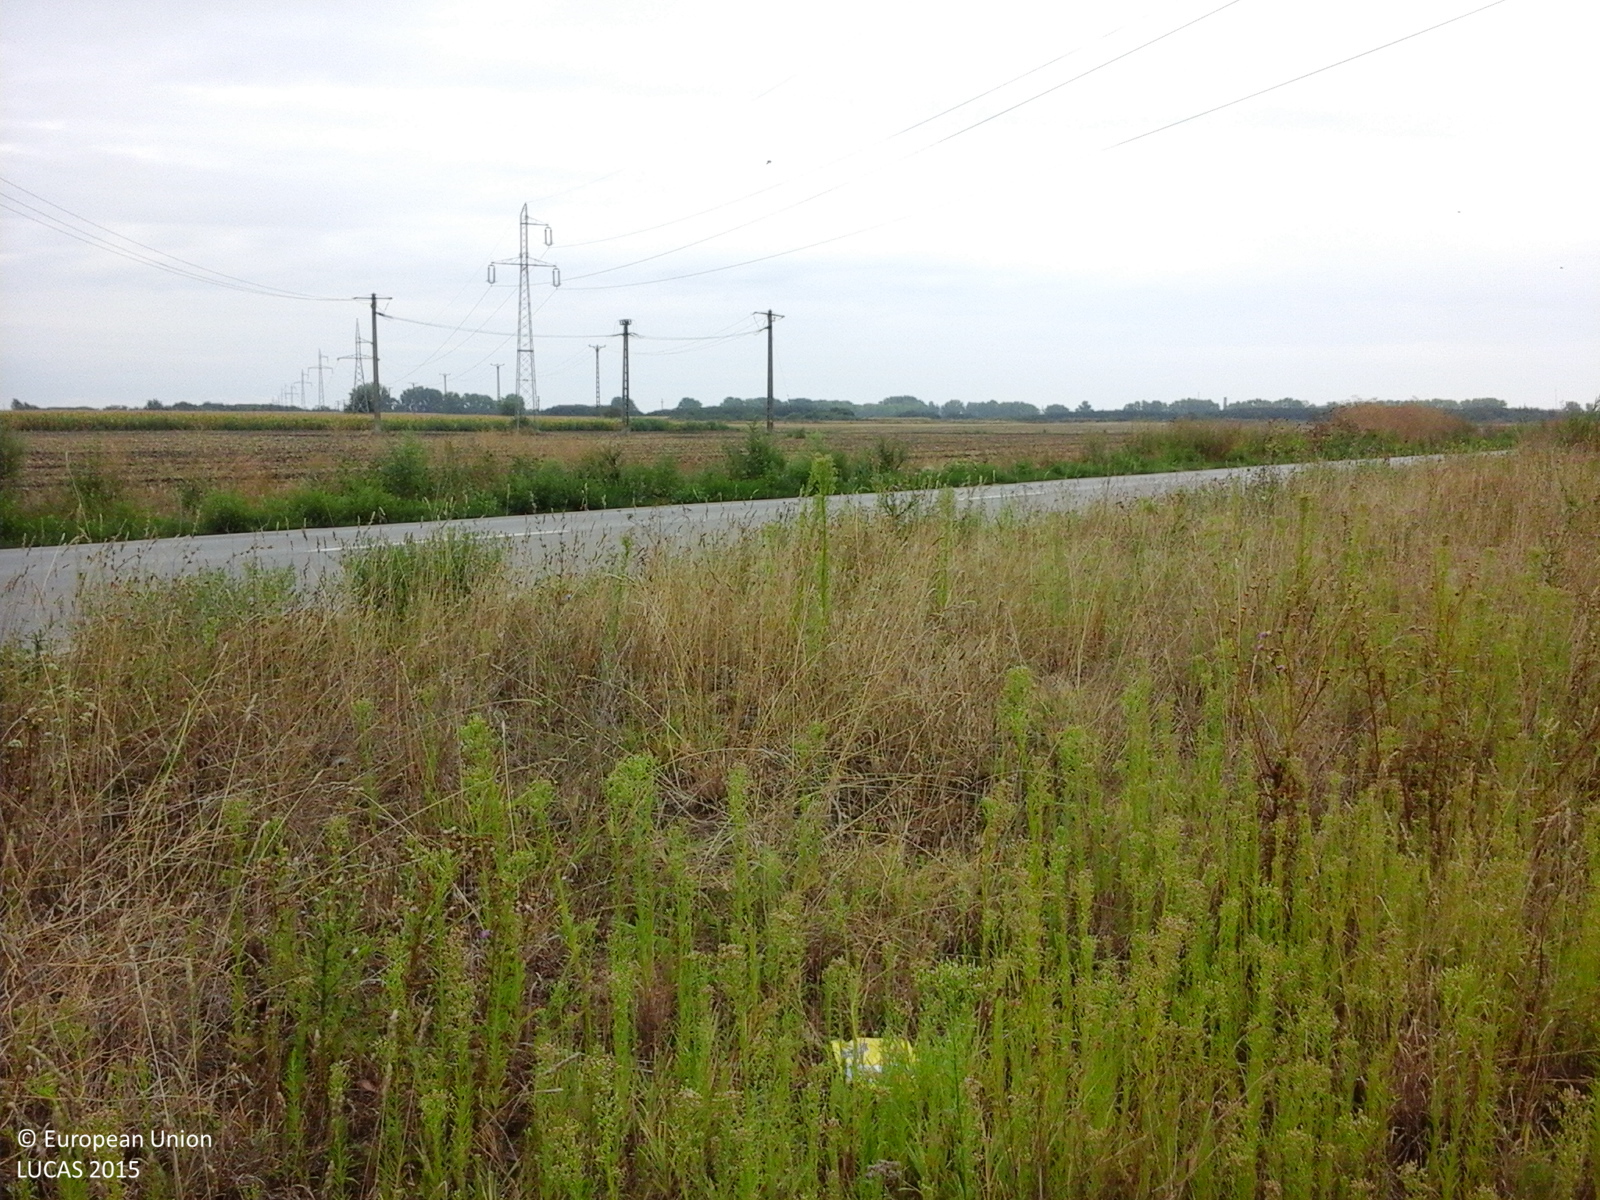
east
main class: Cropland
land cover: Maize
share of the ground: > 75 %
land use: Agriculture (excluding fallow land and kitchen gardens)
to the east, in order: Maize; Grass margins; Ditches and canals
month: August
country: RO
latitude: 45.8135
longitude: 20.6937
